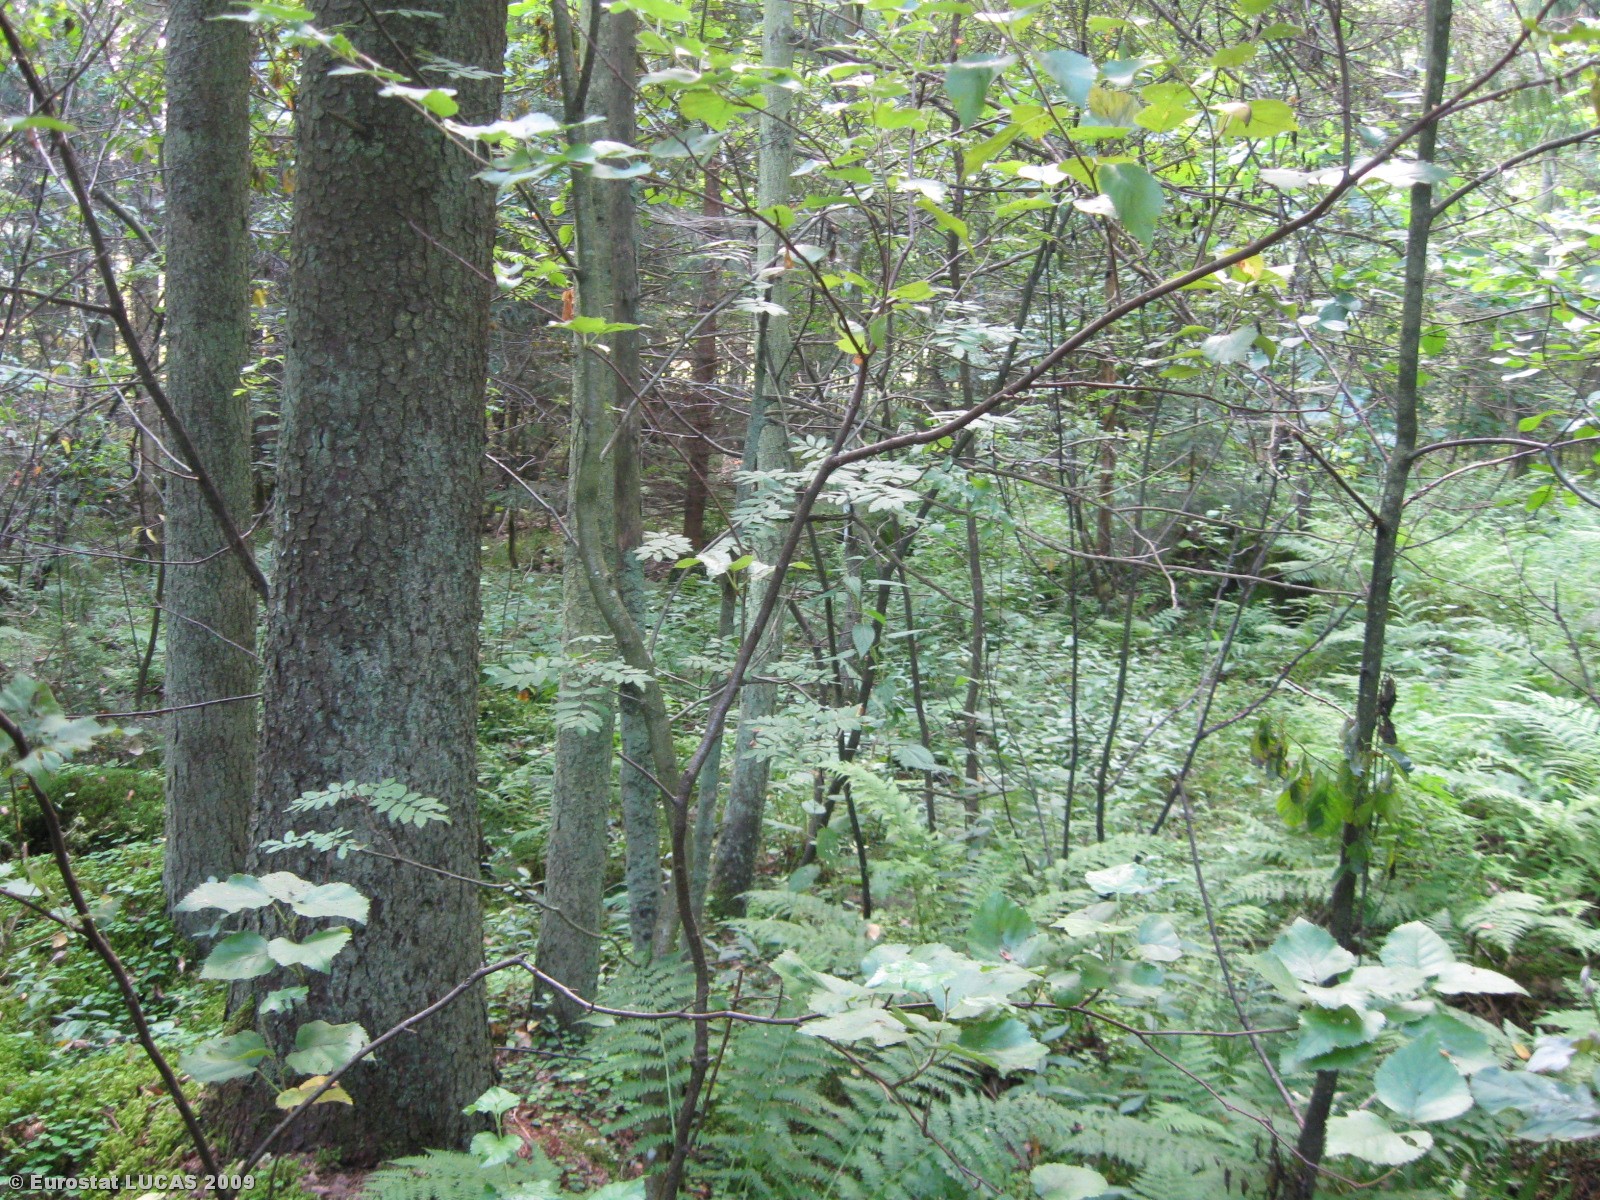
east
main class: Woodland
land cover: Mixed woodland
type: hemiboreal forest and nemoral coniferous forest and mixed broadleaved-coniferous forest
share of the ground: > 75 %
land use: Forestry
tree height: > 5 m
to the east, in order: Mixed woodland; Tracks; Spontaneously vegetated surfaces; Mixed woodland
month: August
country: LT
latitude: 55.2441
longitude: 22.6953
